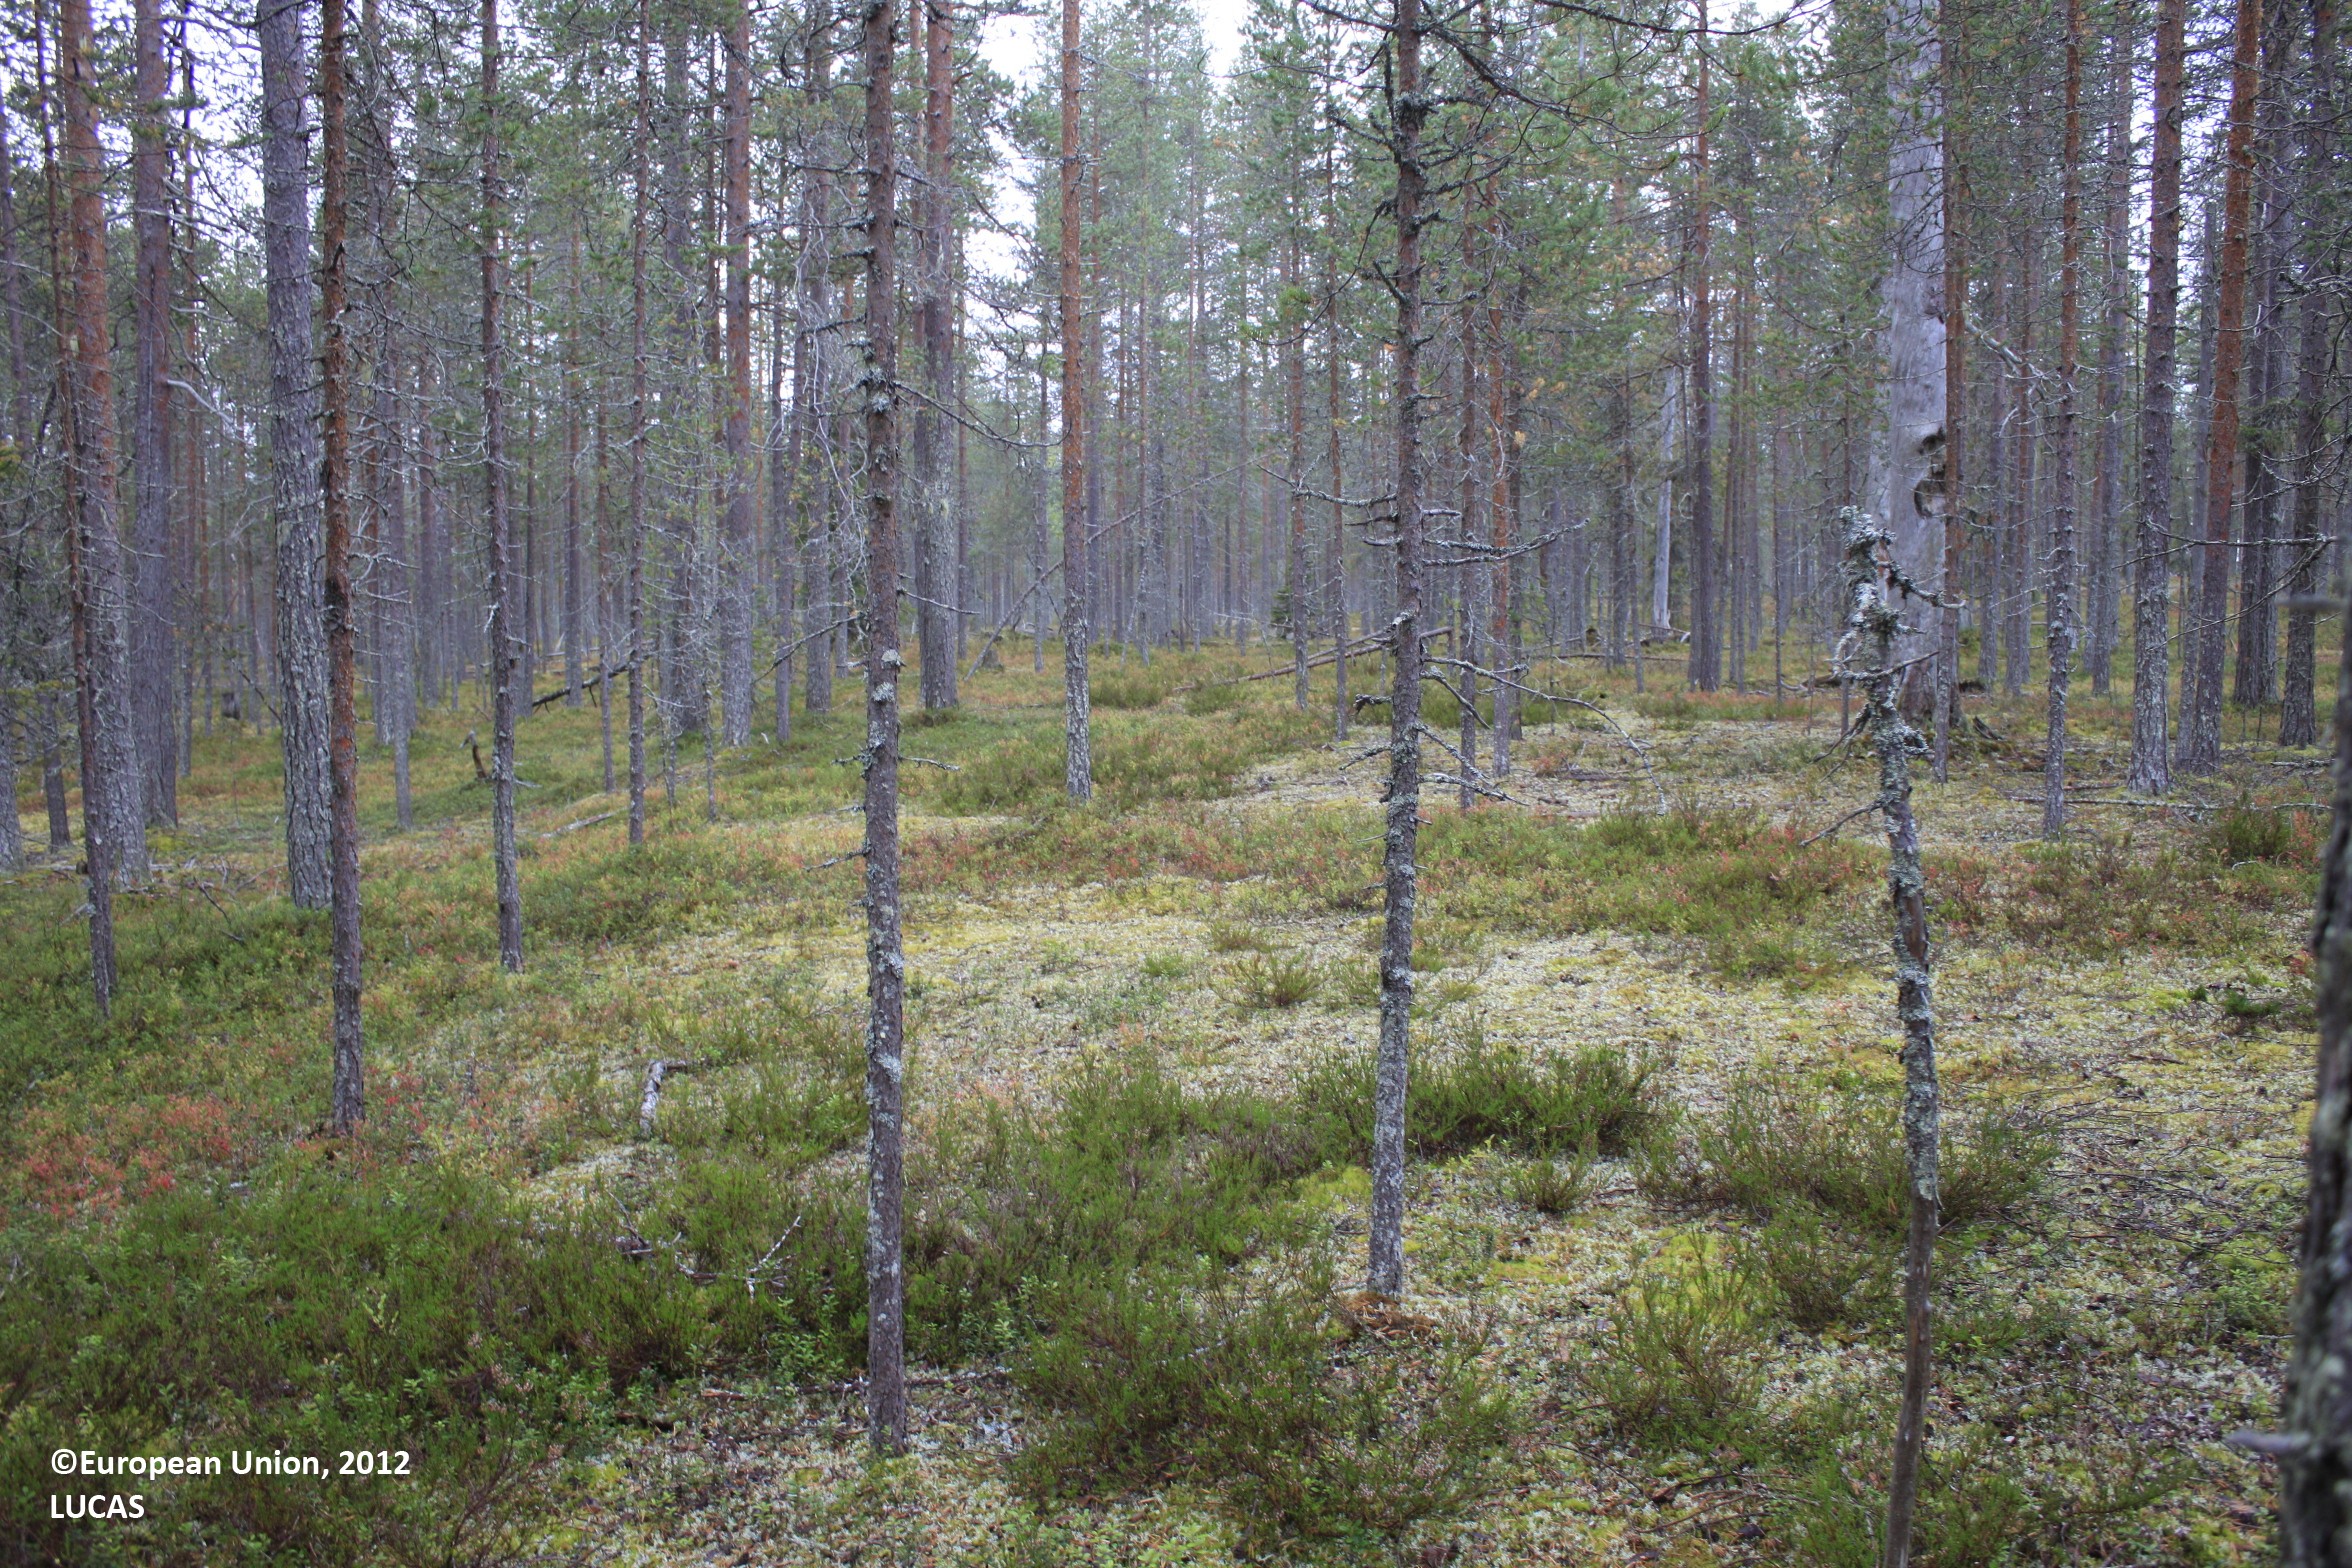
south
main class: Woodland
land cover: Pine dominated coniferous woodland
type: boreal forest
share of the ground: 50 - 75 %
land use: Forestry
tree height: > 5 m
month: September
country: FI
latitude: 65.5409
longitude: 27.1087
